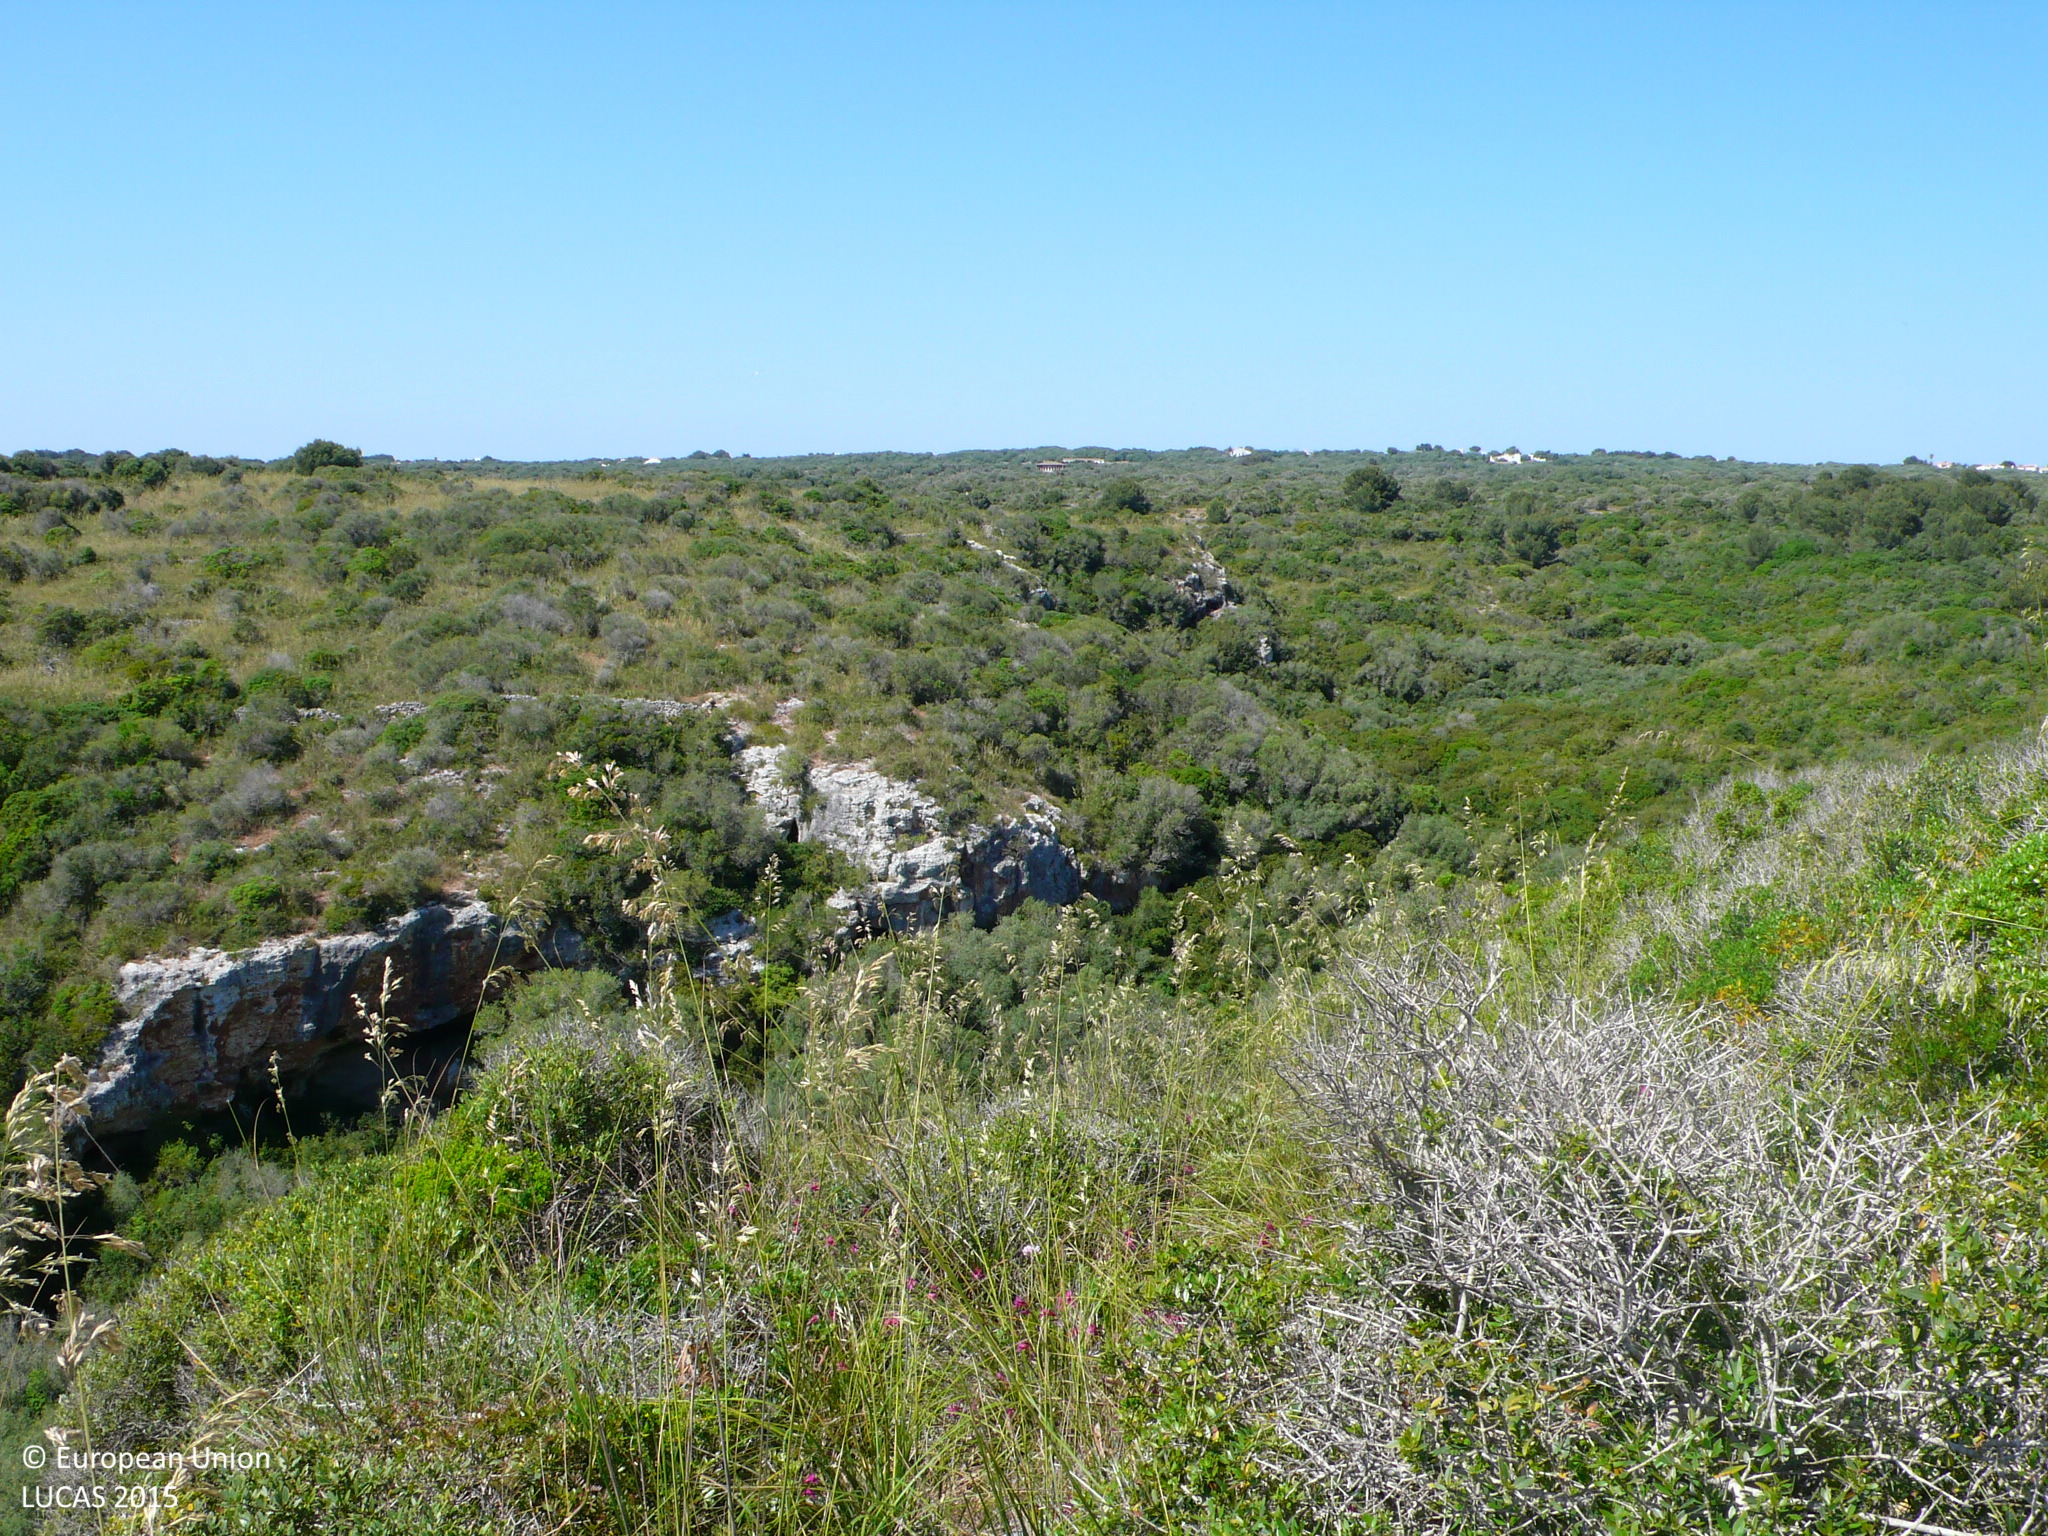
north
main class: Woodland
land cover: Broadleaved woodland
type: broadleaved evergreen forest
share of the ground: 50 - 75 %
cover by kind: broadleaved forest trees 50 %, shrubs 40 %, herbaceous plants 10 %
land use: Semi-natural and natural areas not in use
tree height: > 5 m
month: May
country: ES
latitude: 39.8580
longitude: 4.1702
